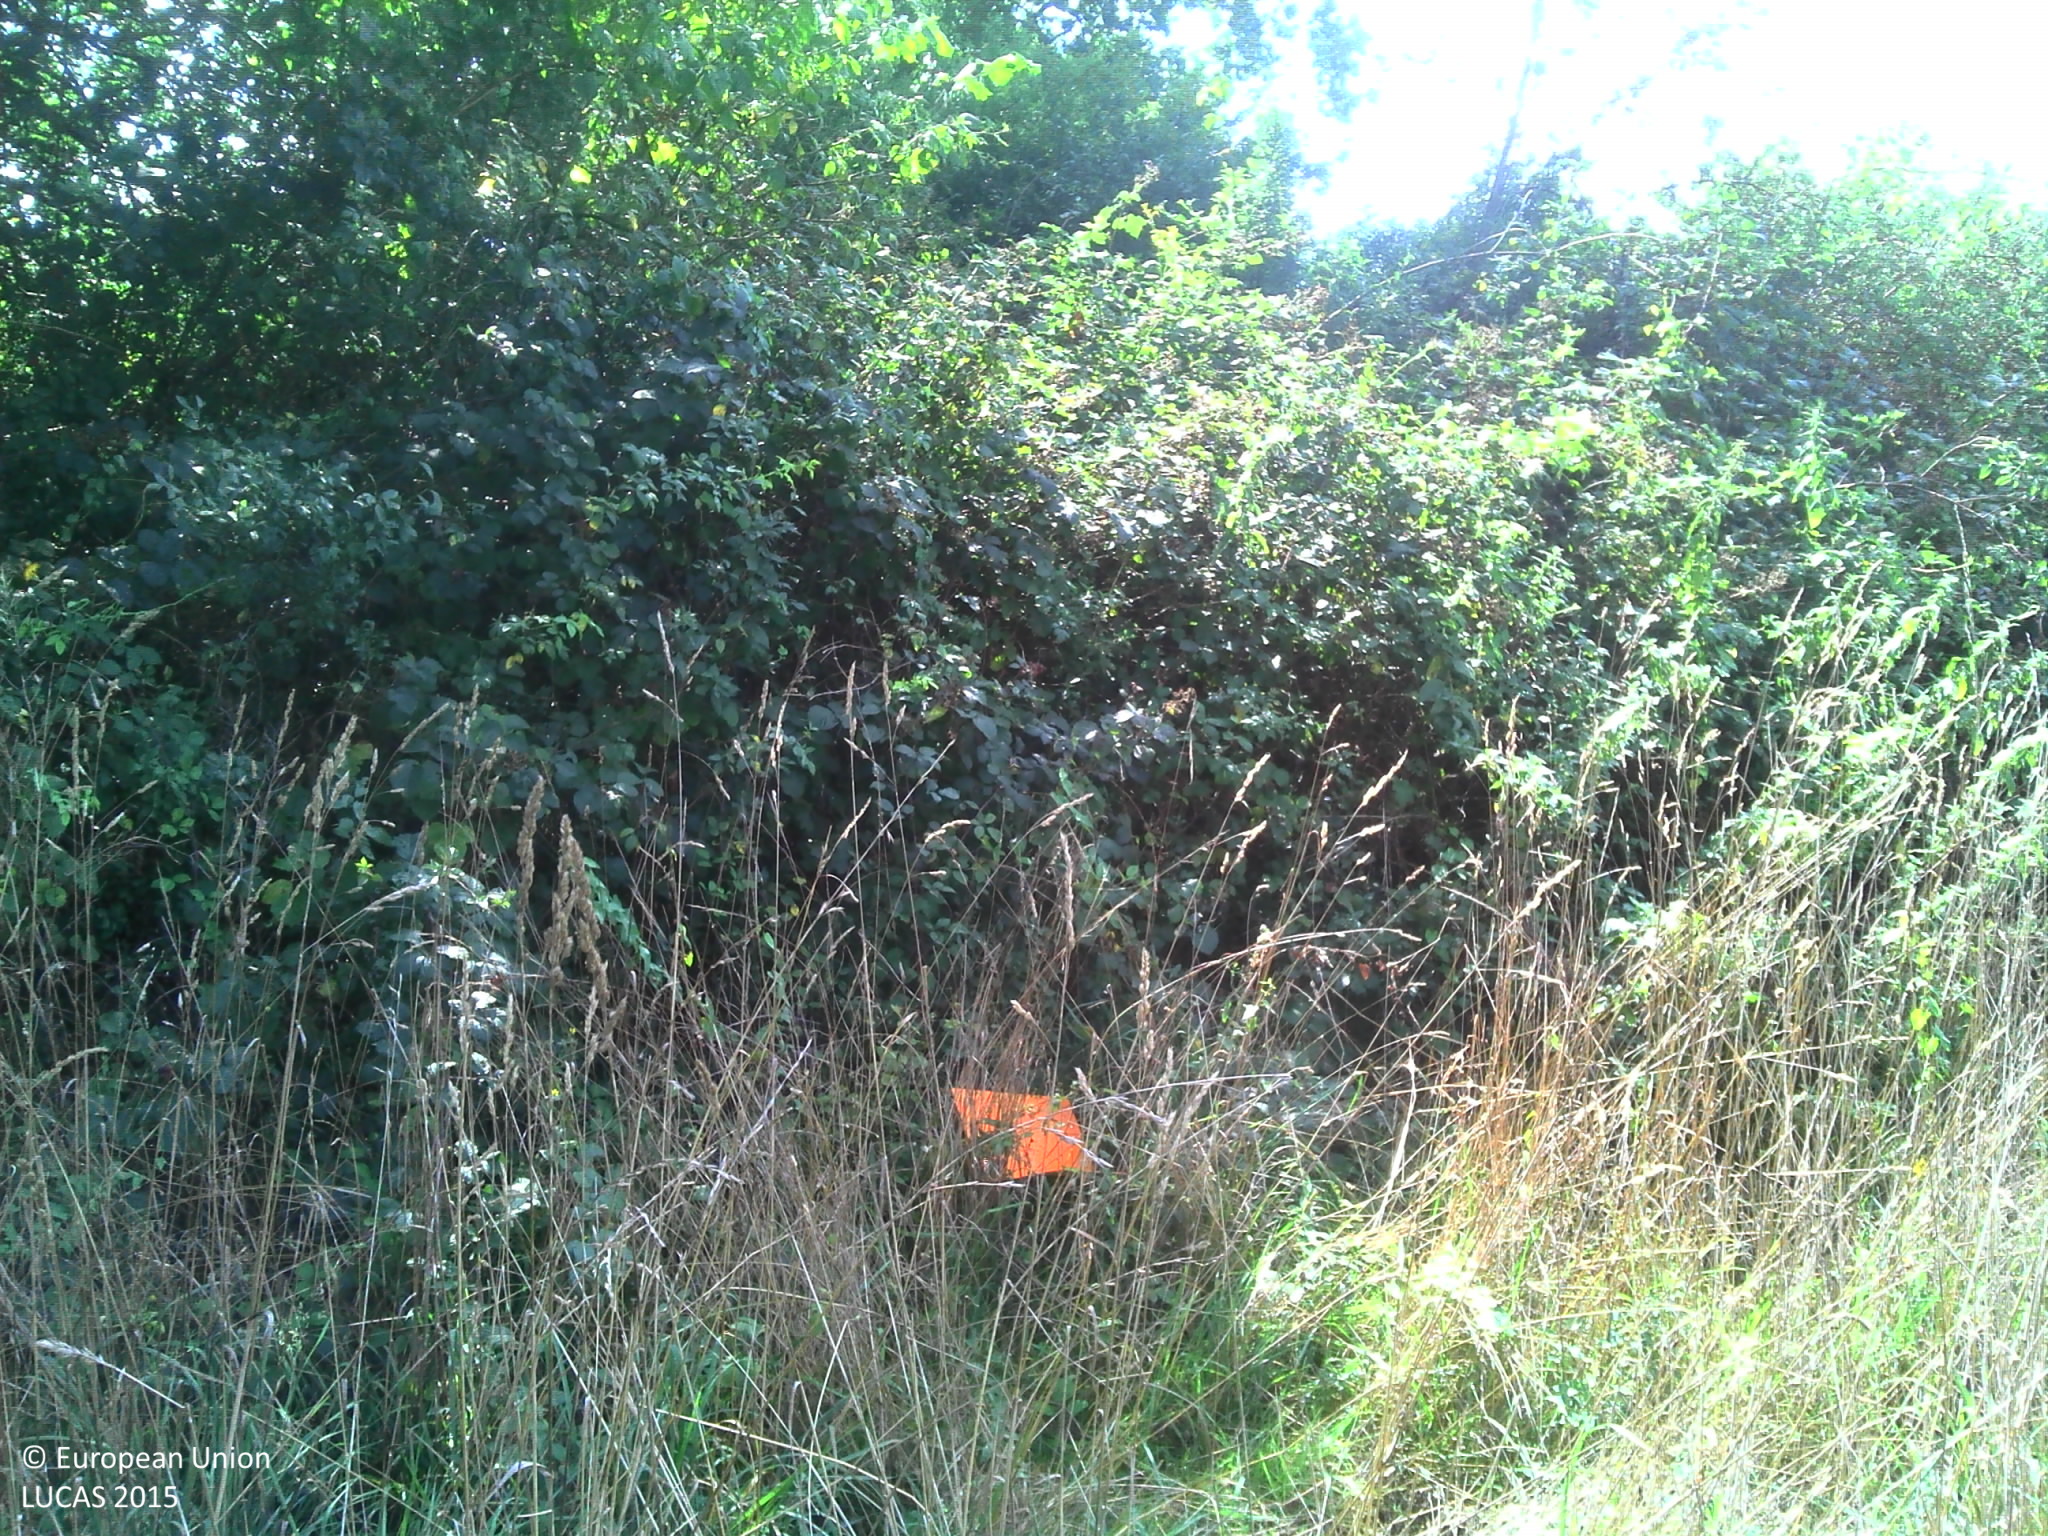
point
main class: Grassland
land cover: Grassland without tree/shrub cover
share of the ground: > 75 %
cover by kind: herbaceous plants 100 %
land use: Agriculture (excluding fallow land and kitchen gardens)
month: September
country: FR
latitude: 47.4763
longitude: 6.8569
